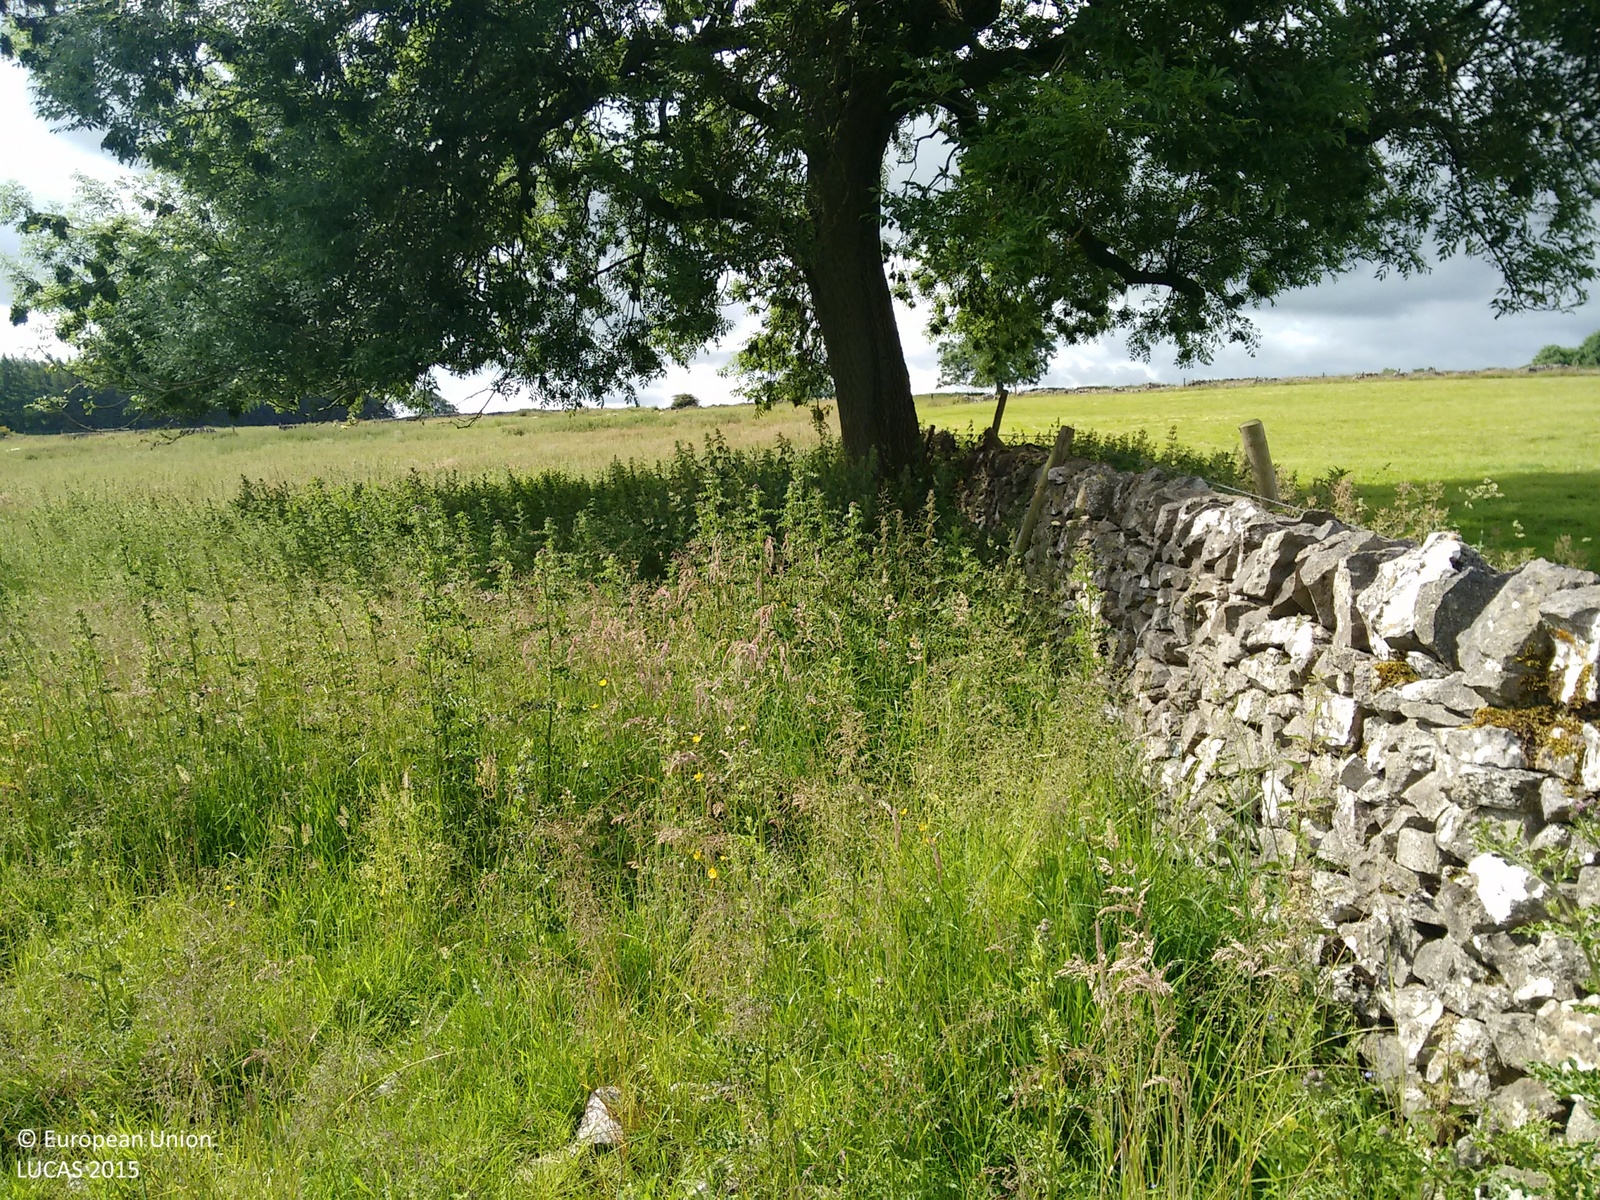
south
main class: Grassland
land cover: Grassland with sparse tree/shrub cover
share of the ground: > 75 %
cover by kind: herbaceous plants 85 %, shrubs 10 %, broadleaved forest trees 5 %
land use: Agriculture (excluding fallow land and kitchen gardens)
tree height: > 5 m
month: July
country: GB
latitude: 53.1564
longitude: -1.7334
